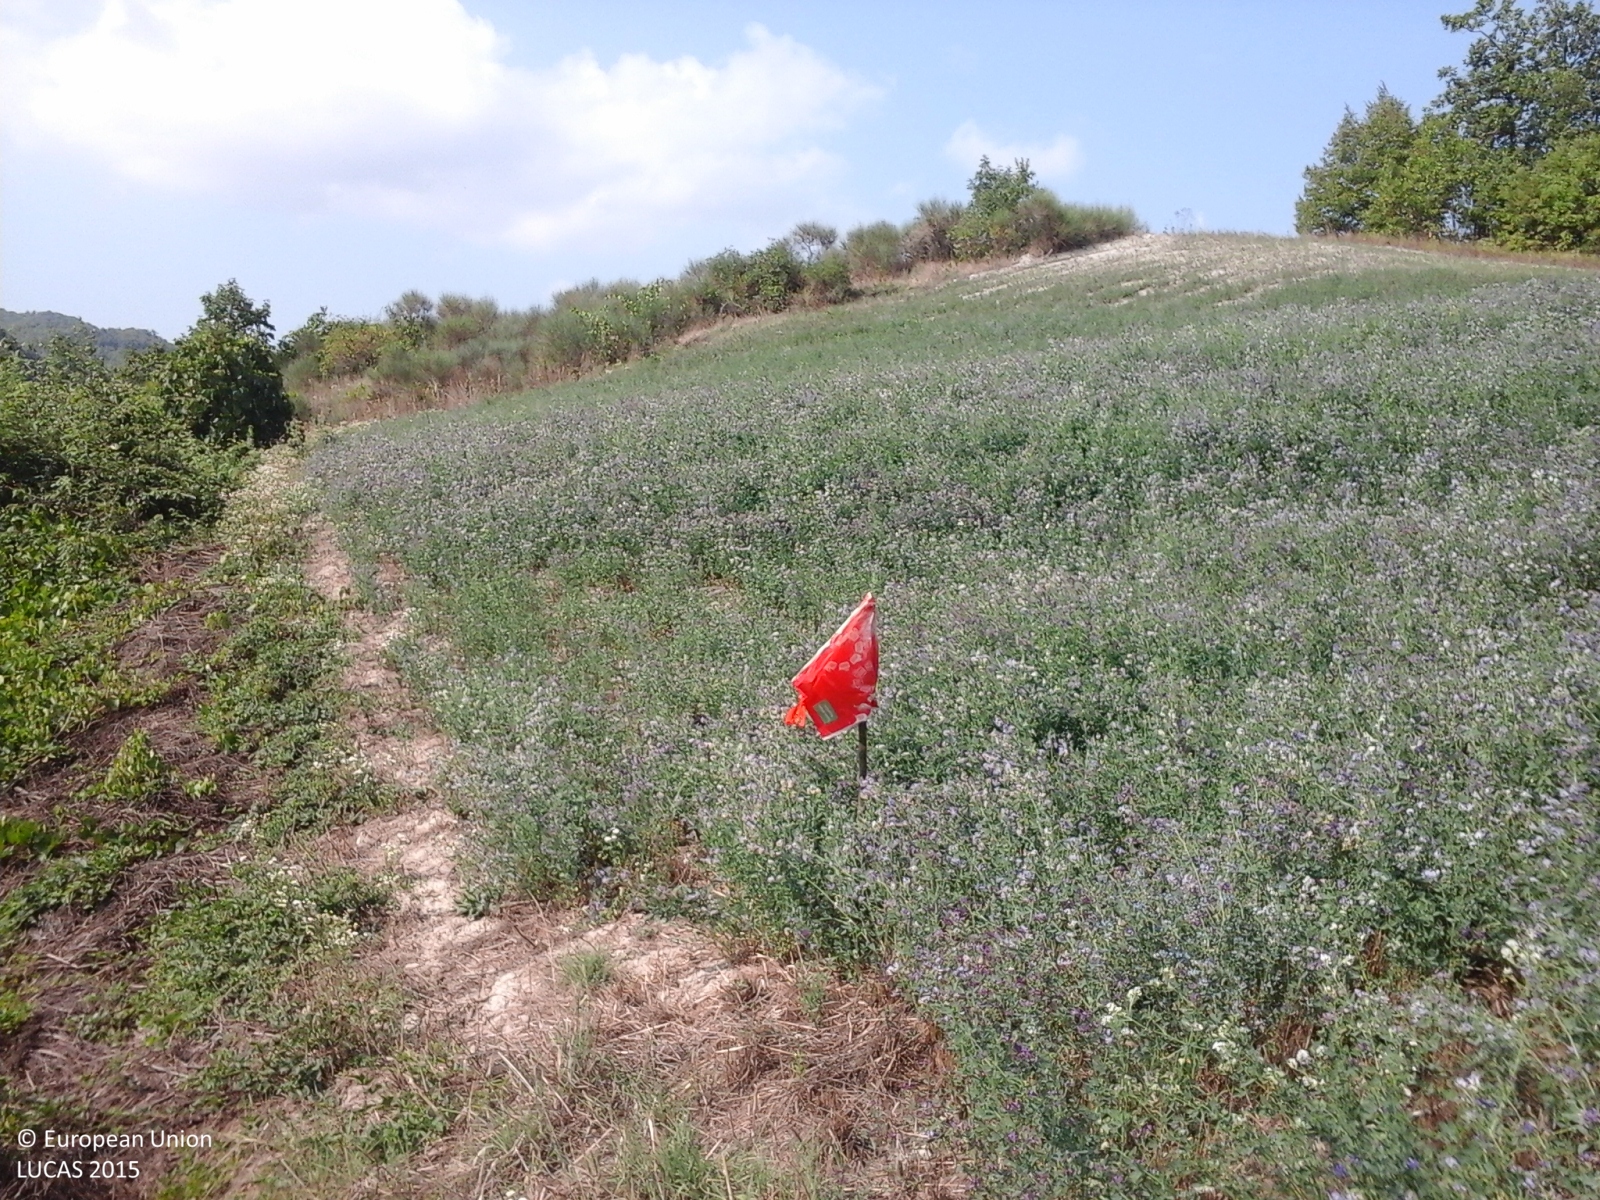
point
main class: Cropland
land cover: Lucerne
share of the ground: > 75 %
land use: Agriculture (excluding fallow land and kitchen gardens)
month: August
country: IT
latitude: 44.9063
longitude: 9.1784
